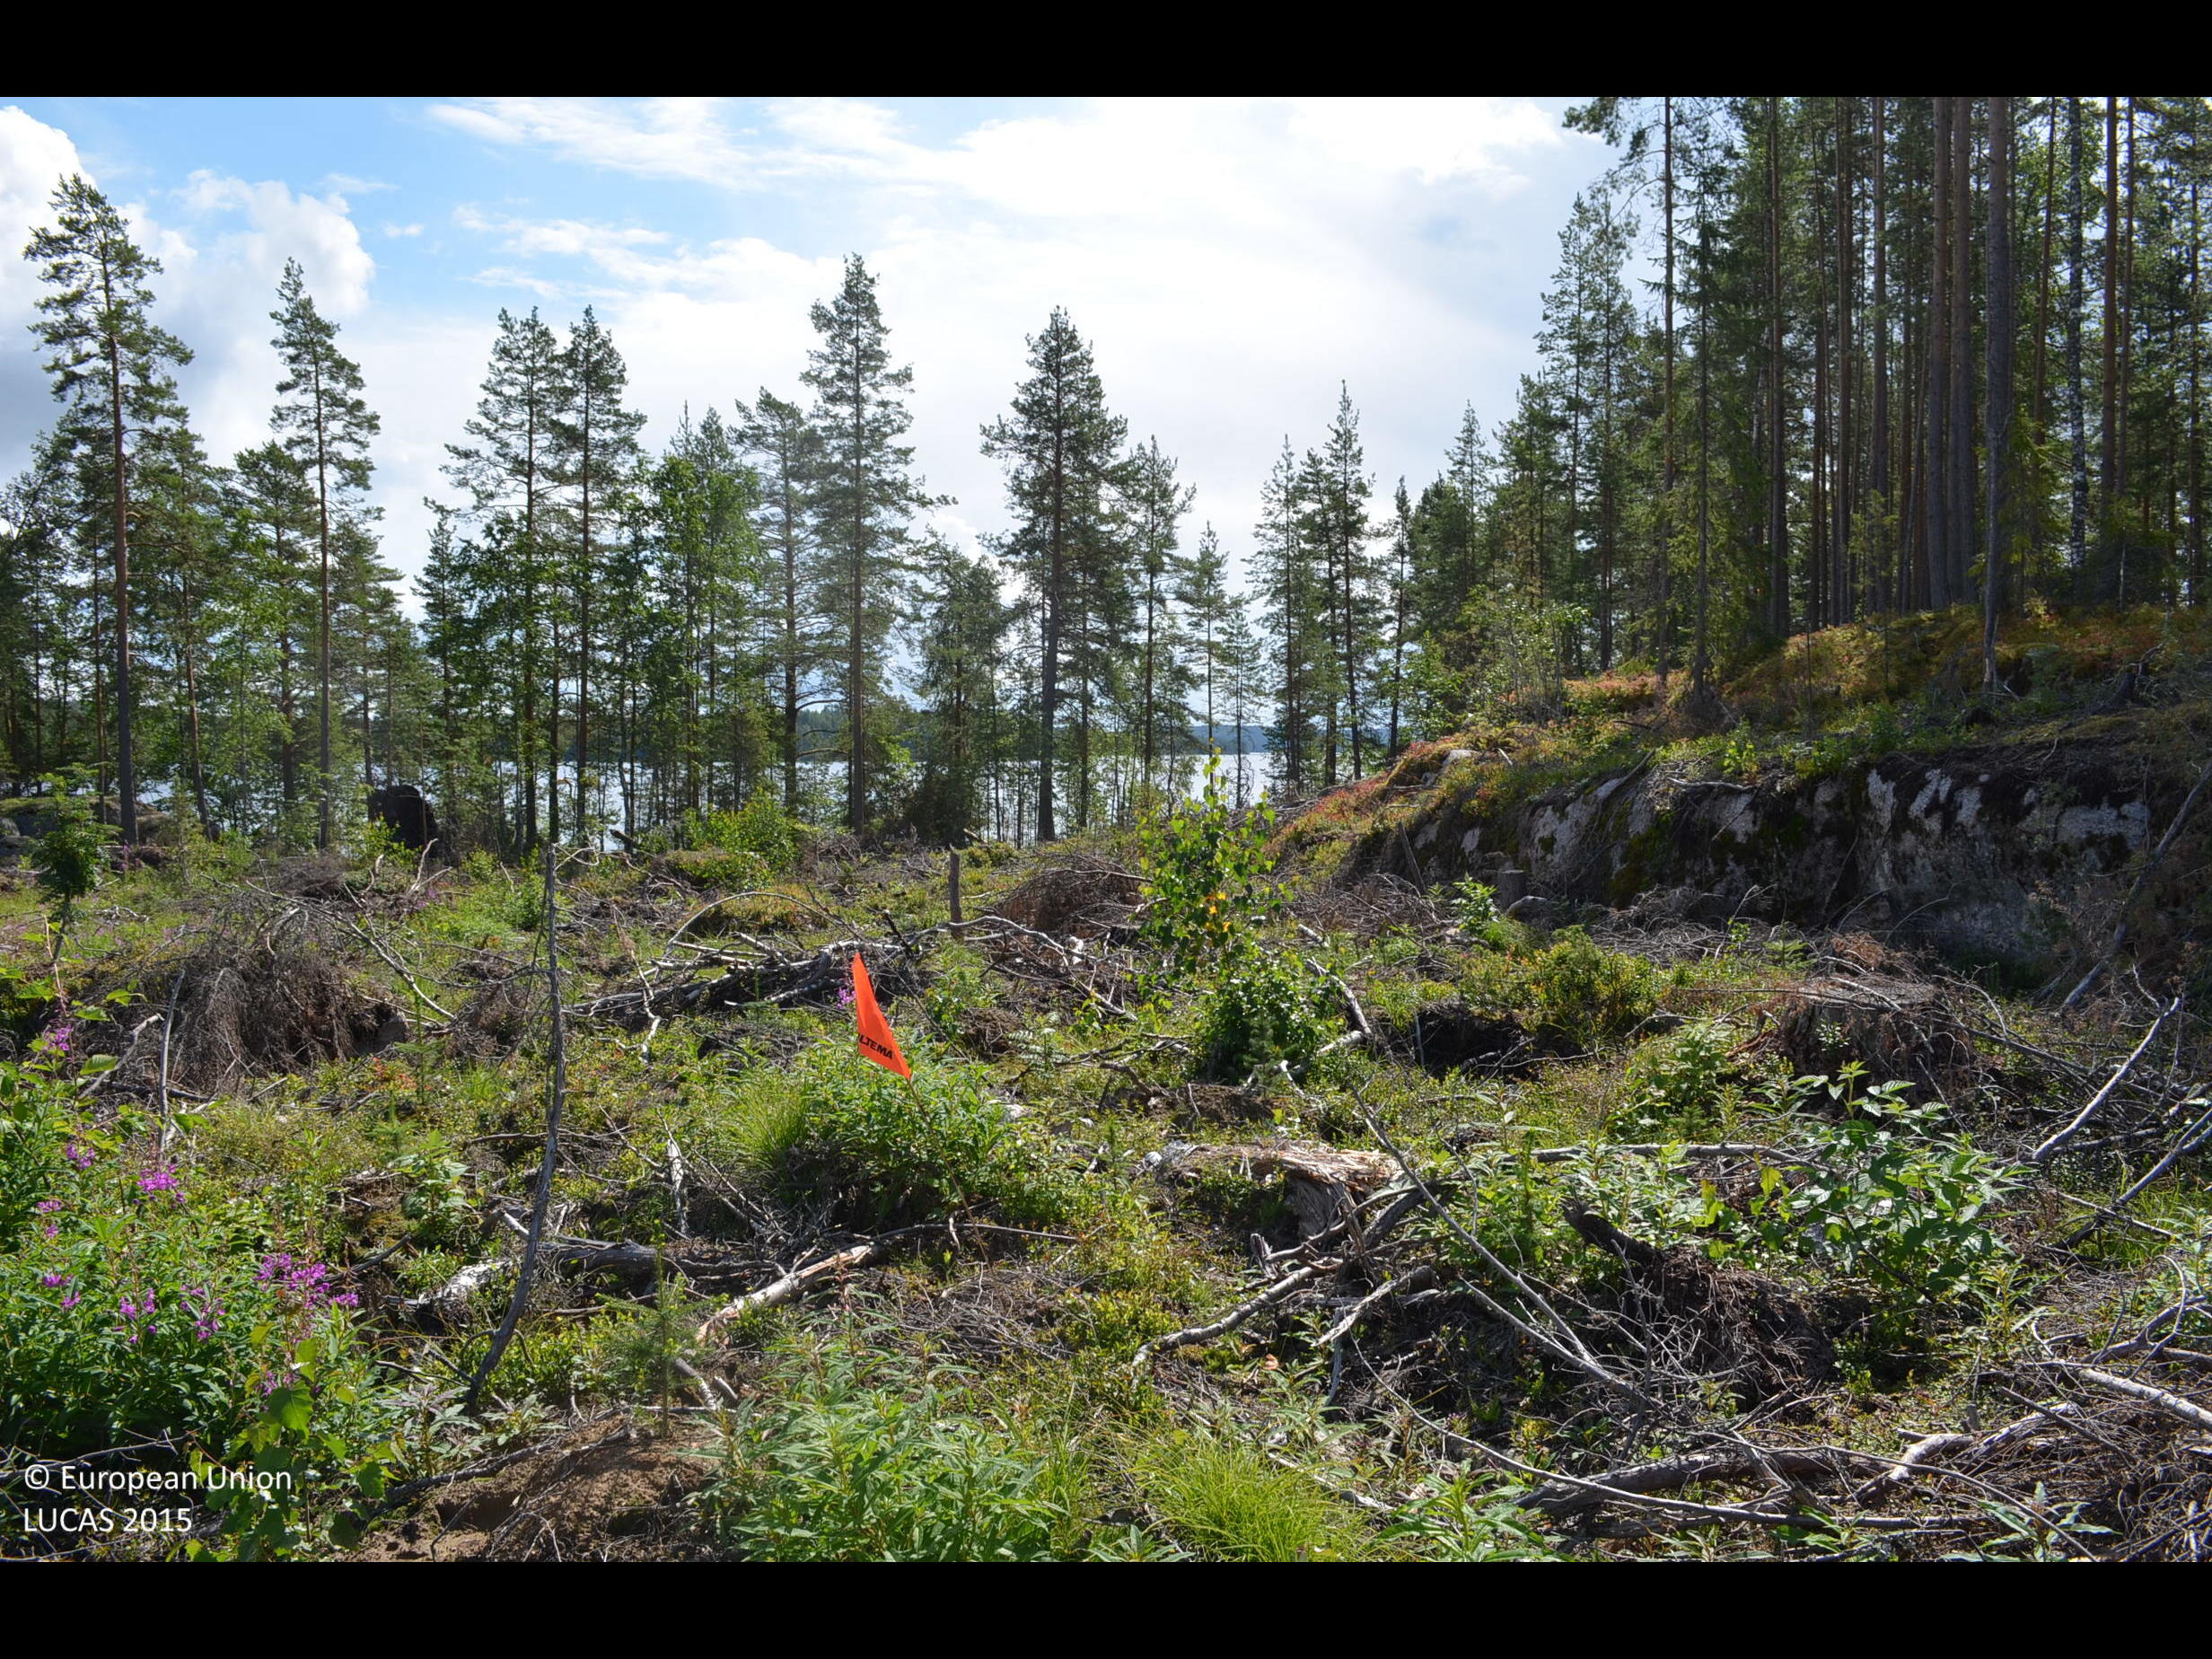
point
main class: Shrubland
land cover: Shrubland with sparse tree cover
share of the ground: 25 - 50 %
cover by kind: shrubs 40 %, herbaceous plants 15 %, consolidated bare surface 15 %, broadleaved forest trees 5 %
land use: Forestry
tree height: < 5 m
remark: Clear cut
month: July
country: FI
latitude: 61.9975
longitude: 24.1195
